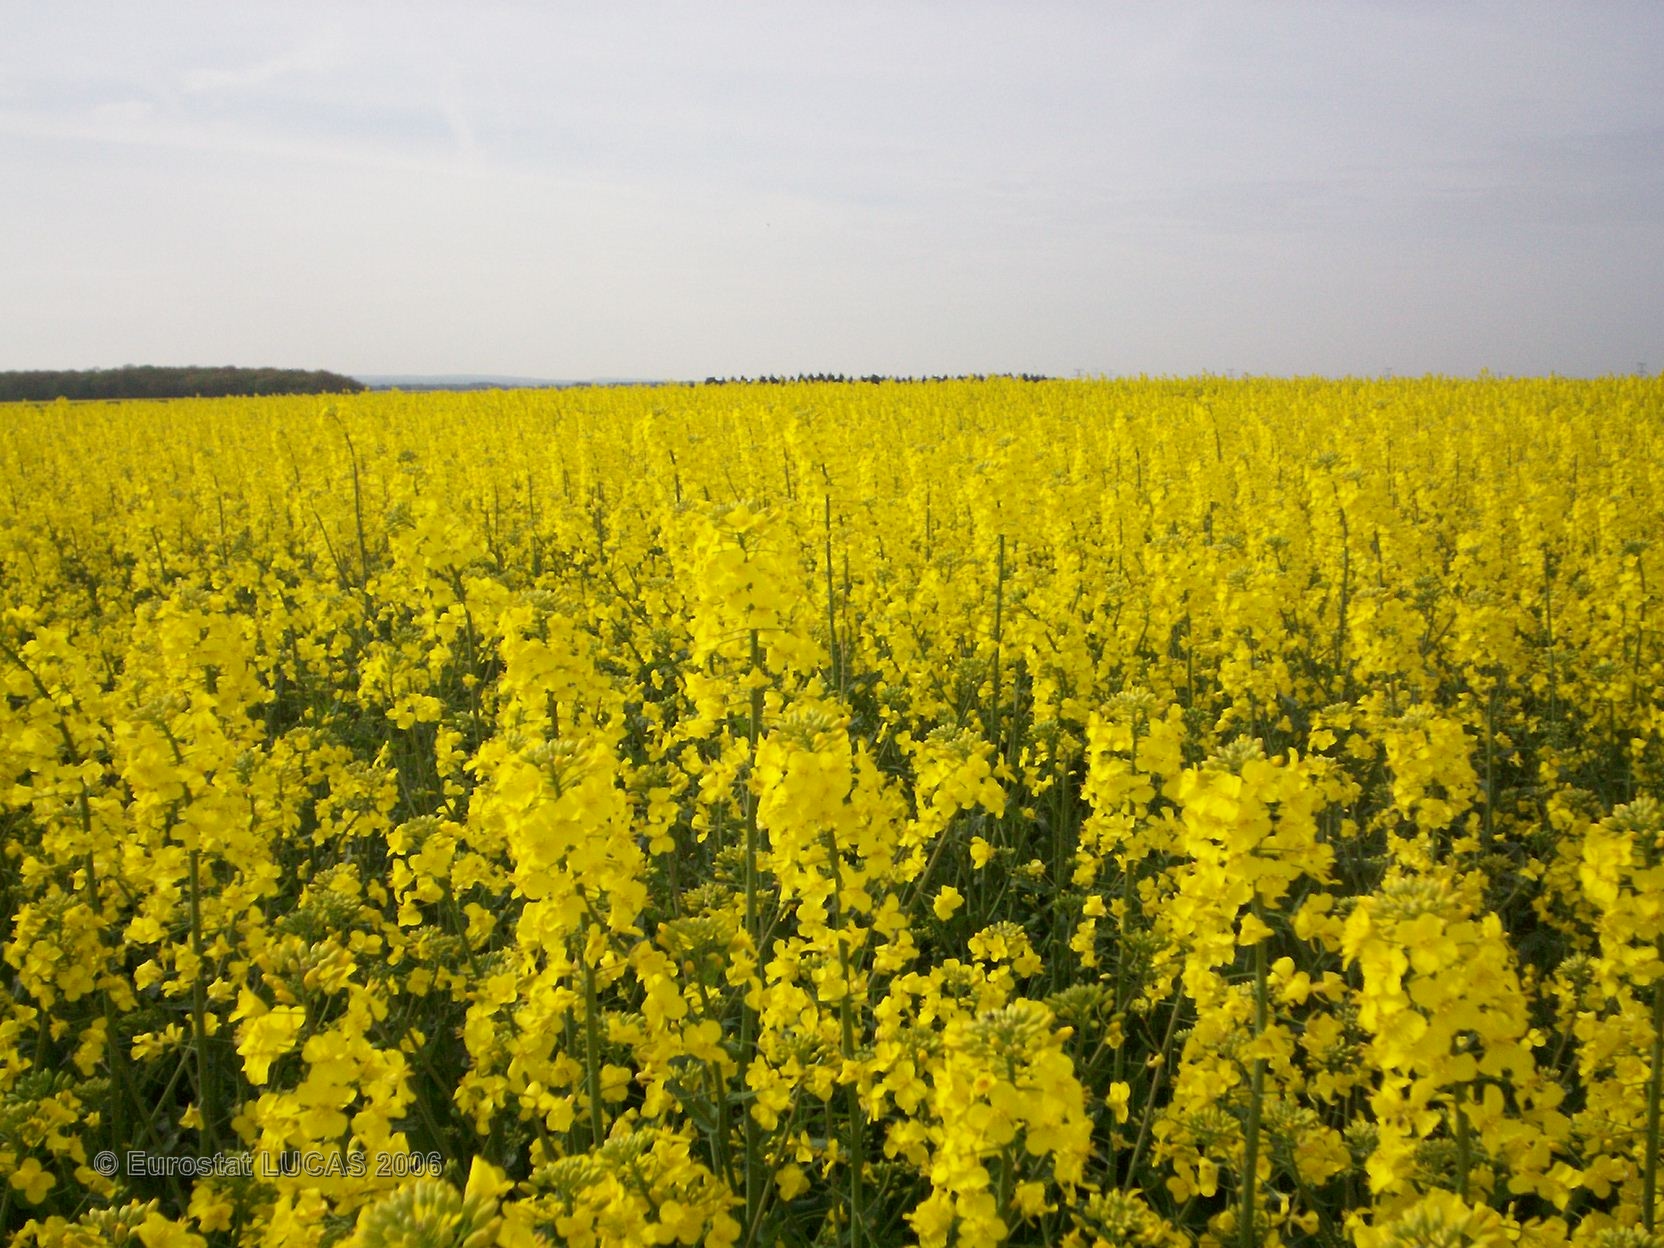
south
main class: Cropland
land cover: Rape and turnip rape
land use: Agriculture (excluding fallow land and kitchen gardens)
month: May
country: FR
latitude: 47.2998
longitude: 3.0518
